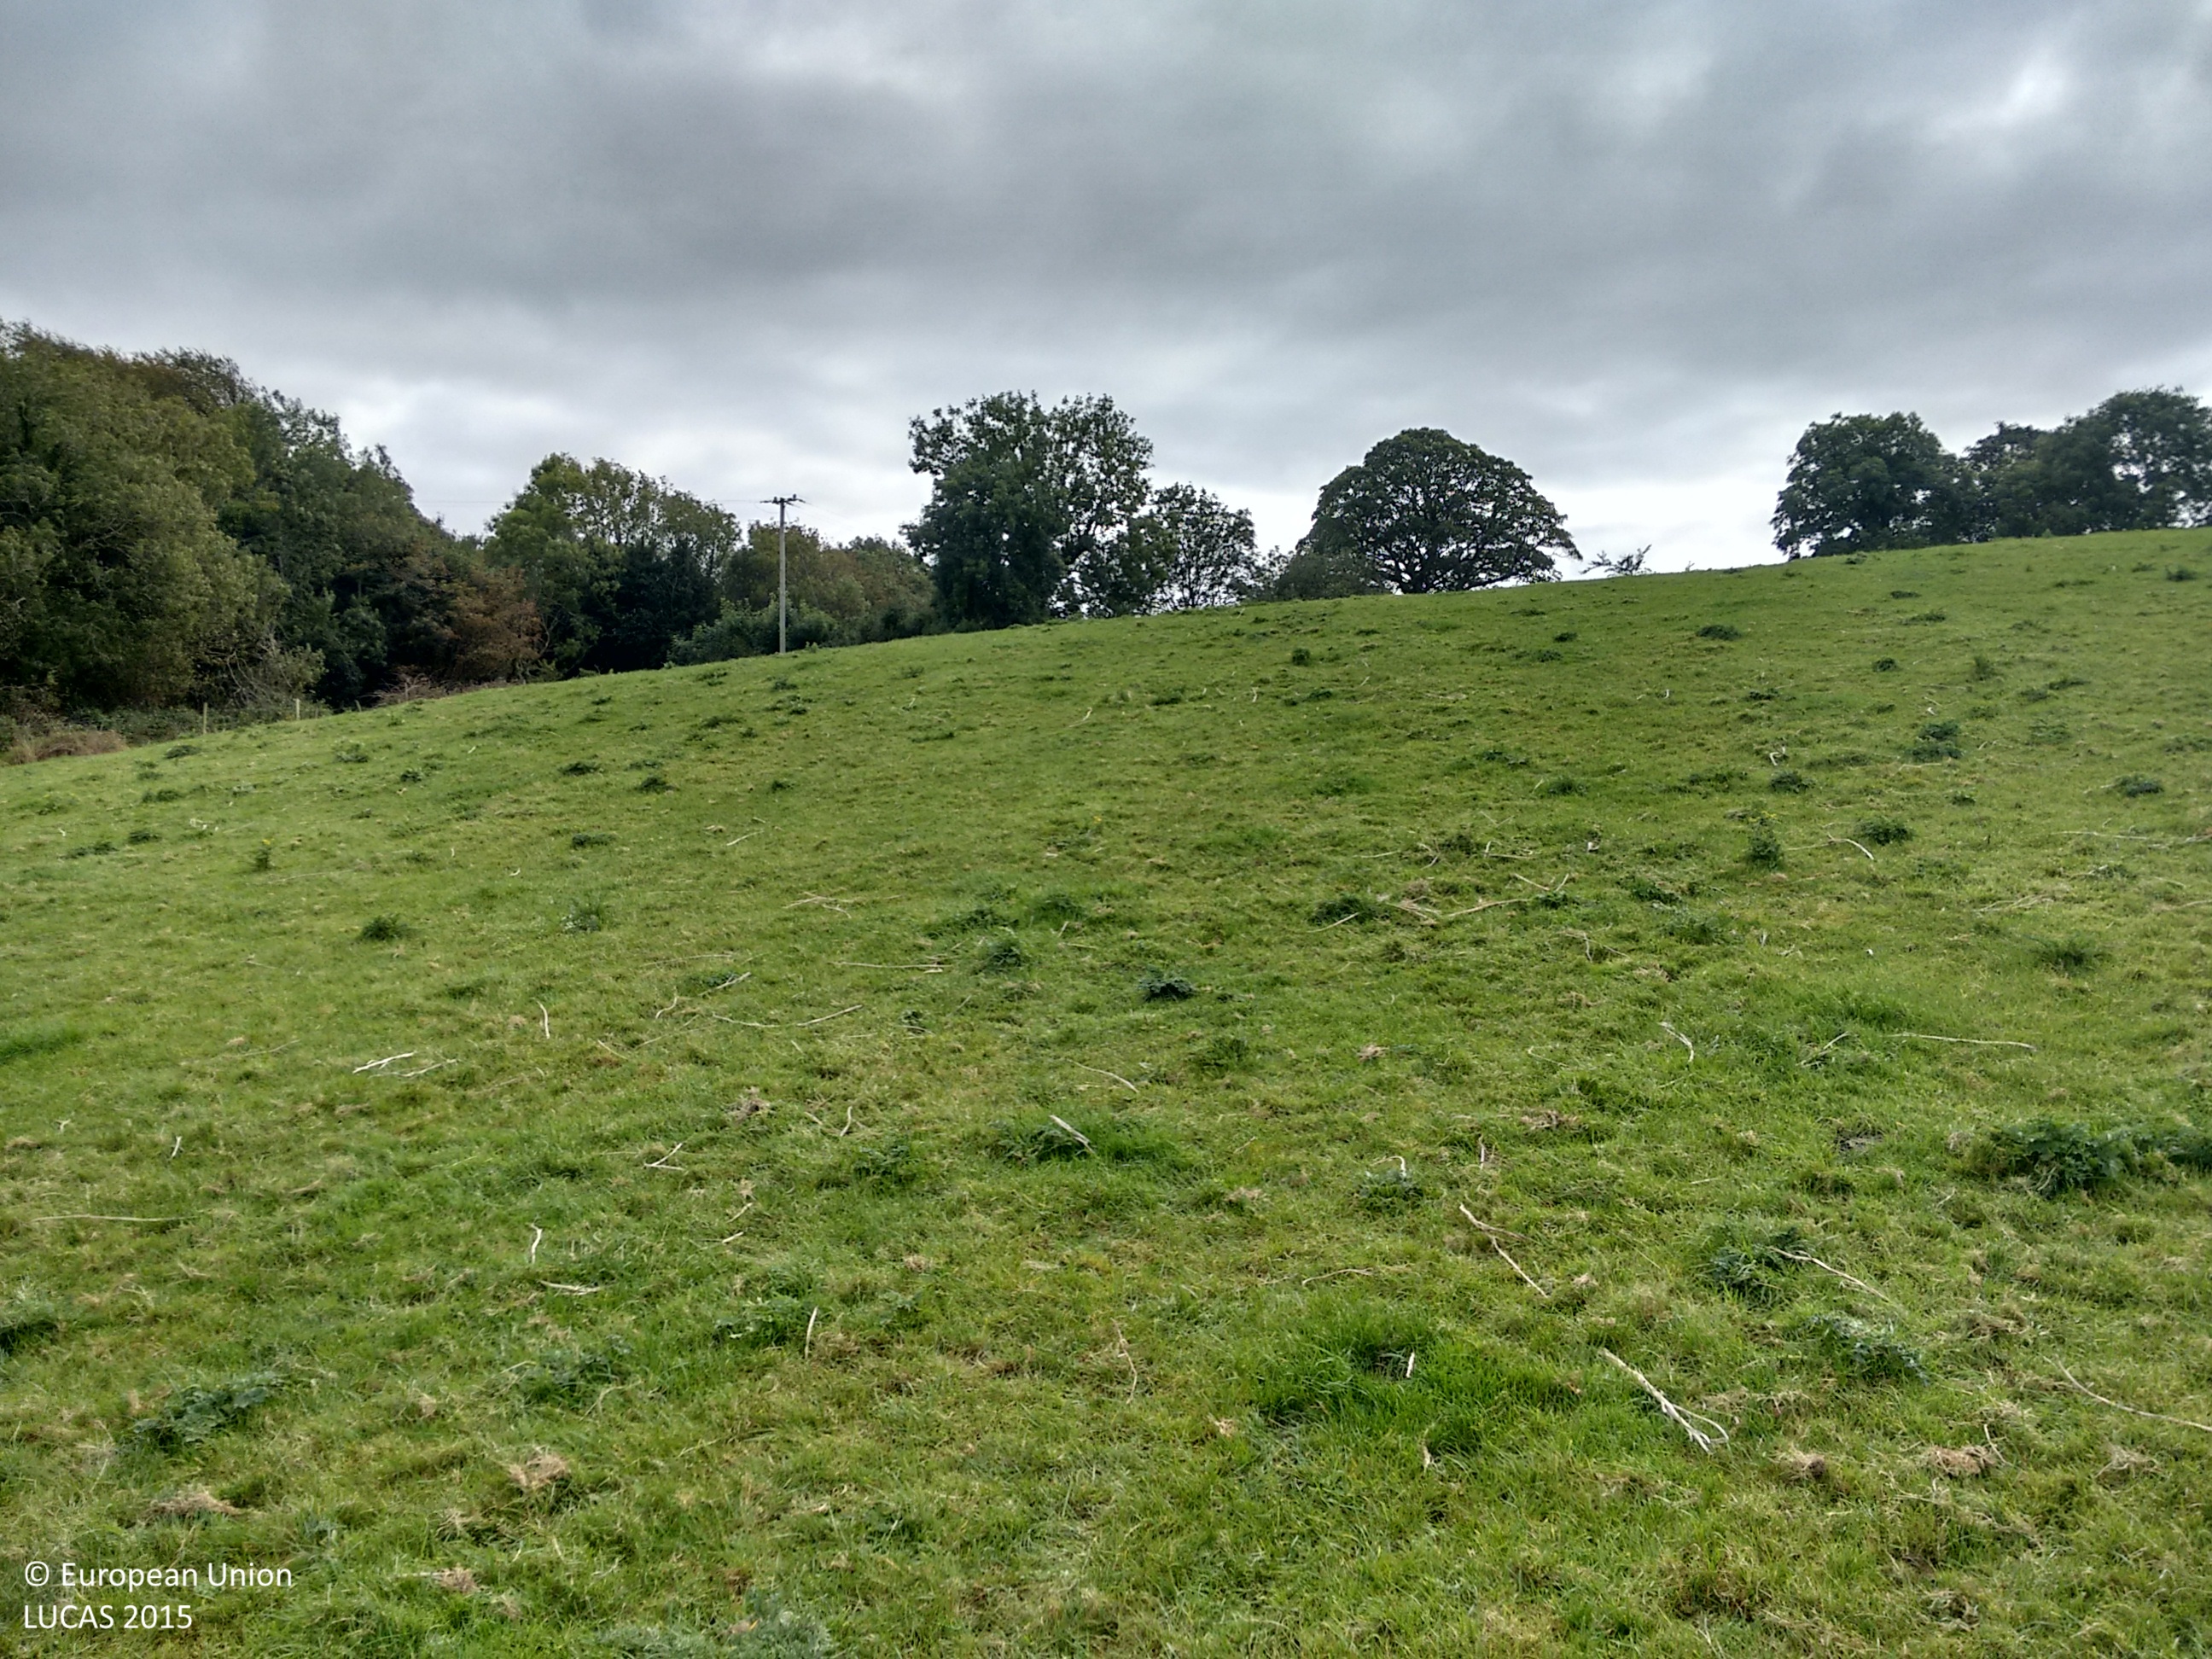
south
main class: Grassland
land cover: Grassland without tree/shrub cover
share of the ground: > 75 %
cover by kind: herbaceous plants 100 %
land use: Agriculture (excluding fallow land and kitchen gardens)
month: September
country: IE
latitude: 52.5672
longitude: -9.3010
